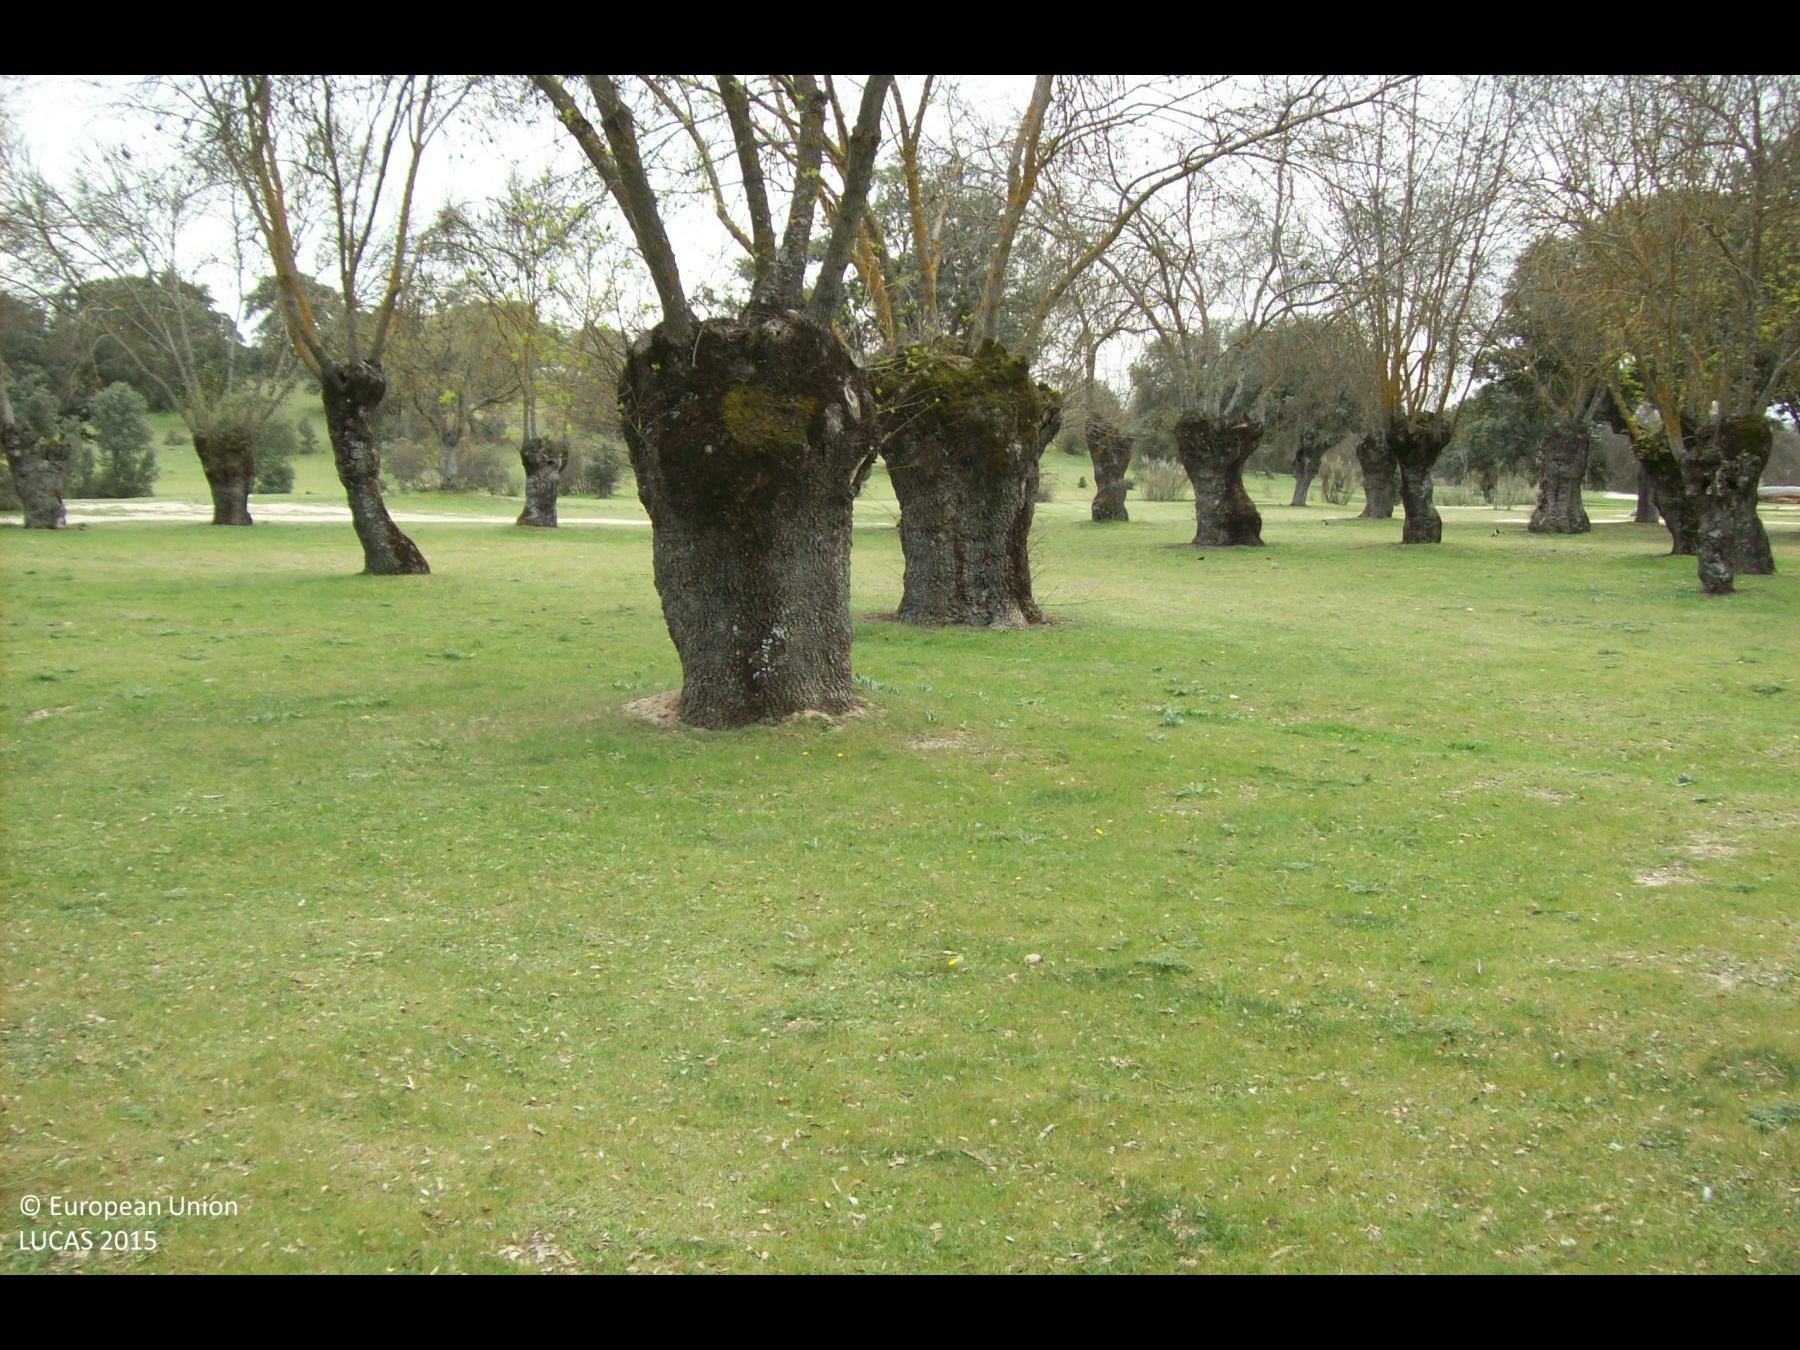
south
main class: Woodland
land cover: Broadleaved woodland
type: thermophilous deciduous forest
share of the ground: 25 - 50 %
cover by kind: broadleaved forest trees 45 %, herbaceous plants 45 %
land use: Amenities, museums, leisure
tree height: > 5 m
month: April
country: ES
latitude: 40.4139
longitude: -3.8632
